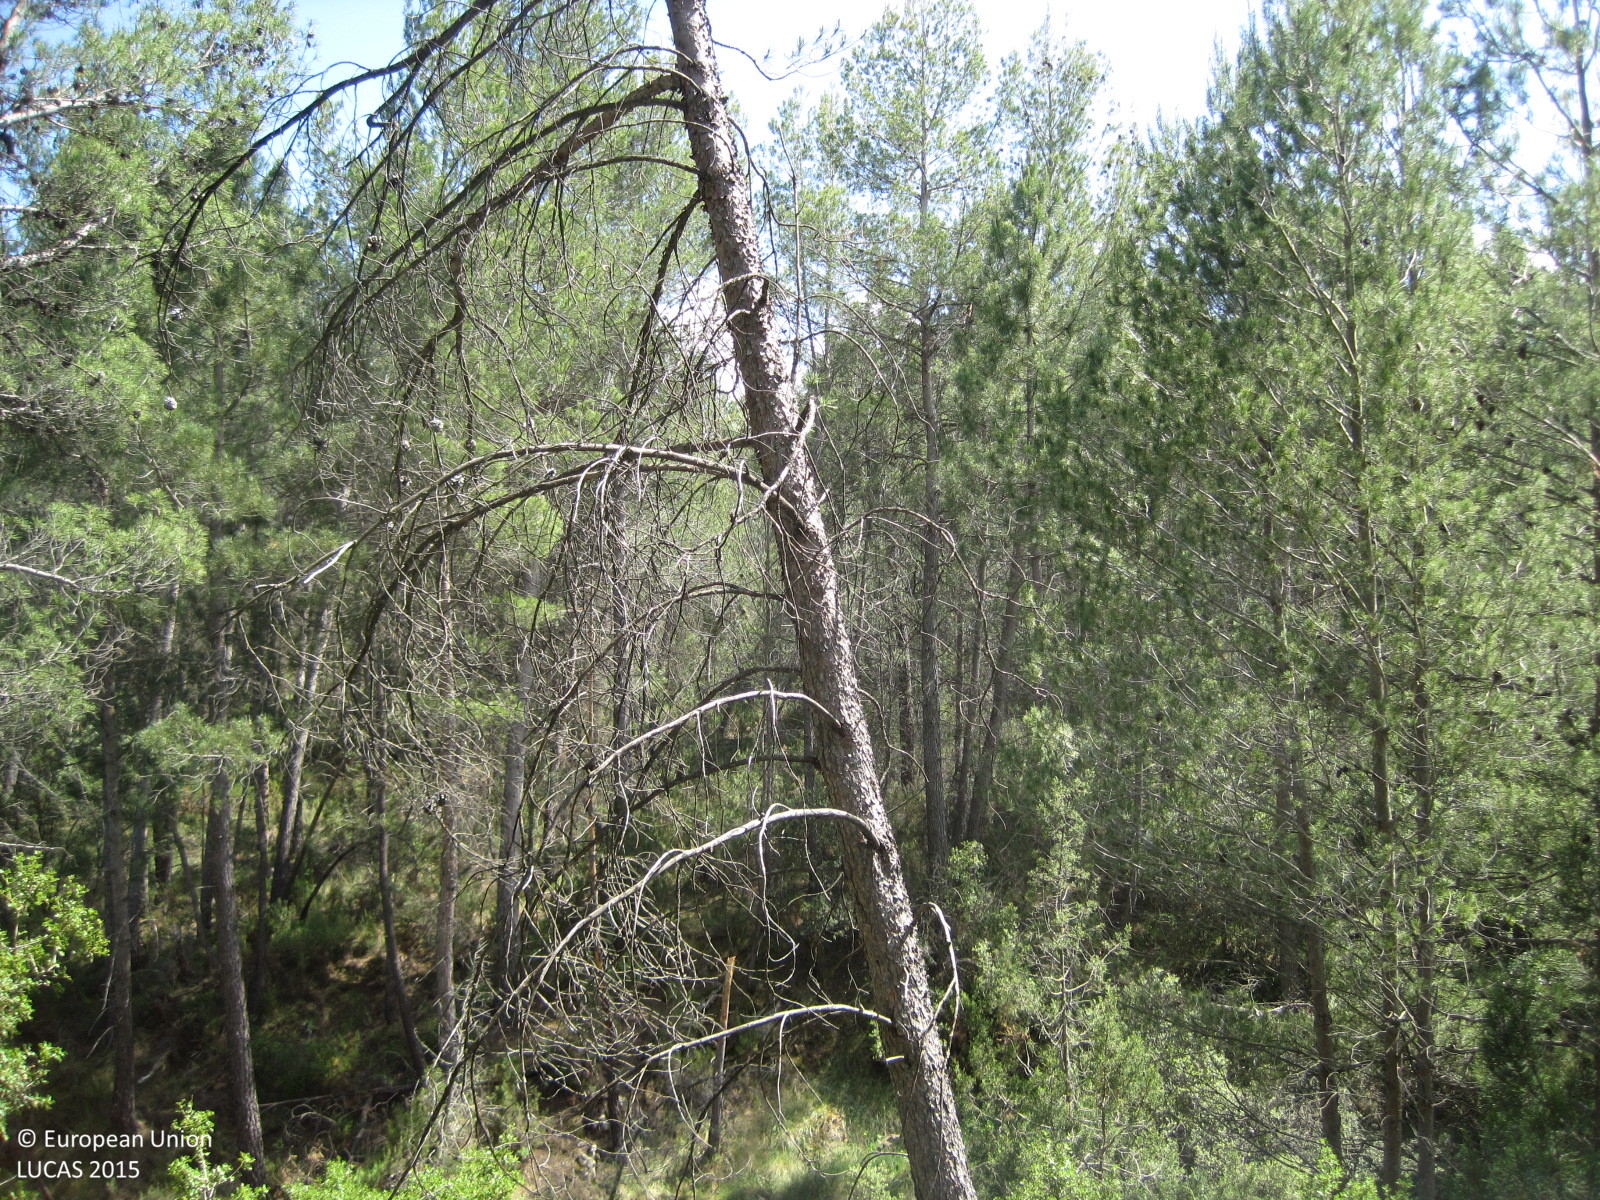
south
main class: Woodland
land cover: Pine dominated coniferous woodland
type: coniferous forest of the mediterranean region
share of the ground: 25 - 50 %
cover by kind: coniferous forest trees 40 %, shrubs 40 %, herbaceous plants 10 %, consolidated bare surface 10 %
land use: Forestry
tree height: > 5 m
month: June
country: ES
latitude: 39.7036
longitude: -1.1421
